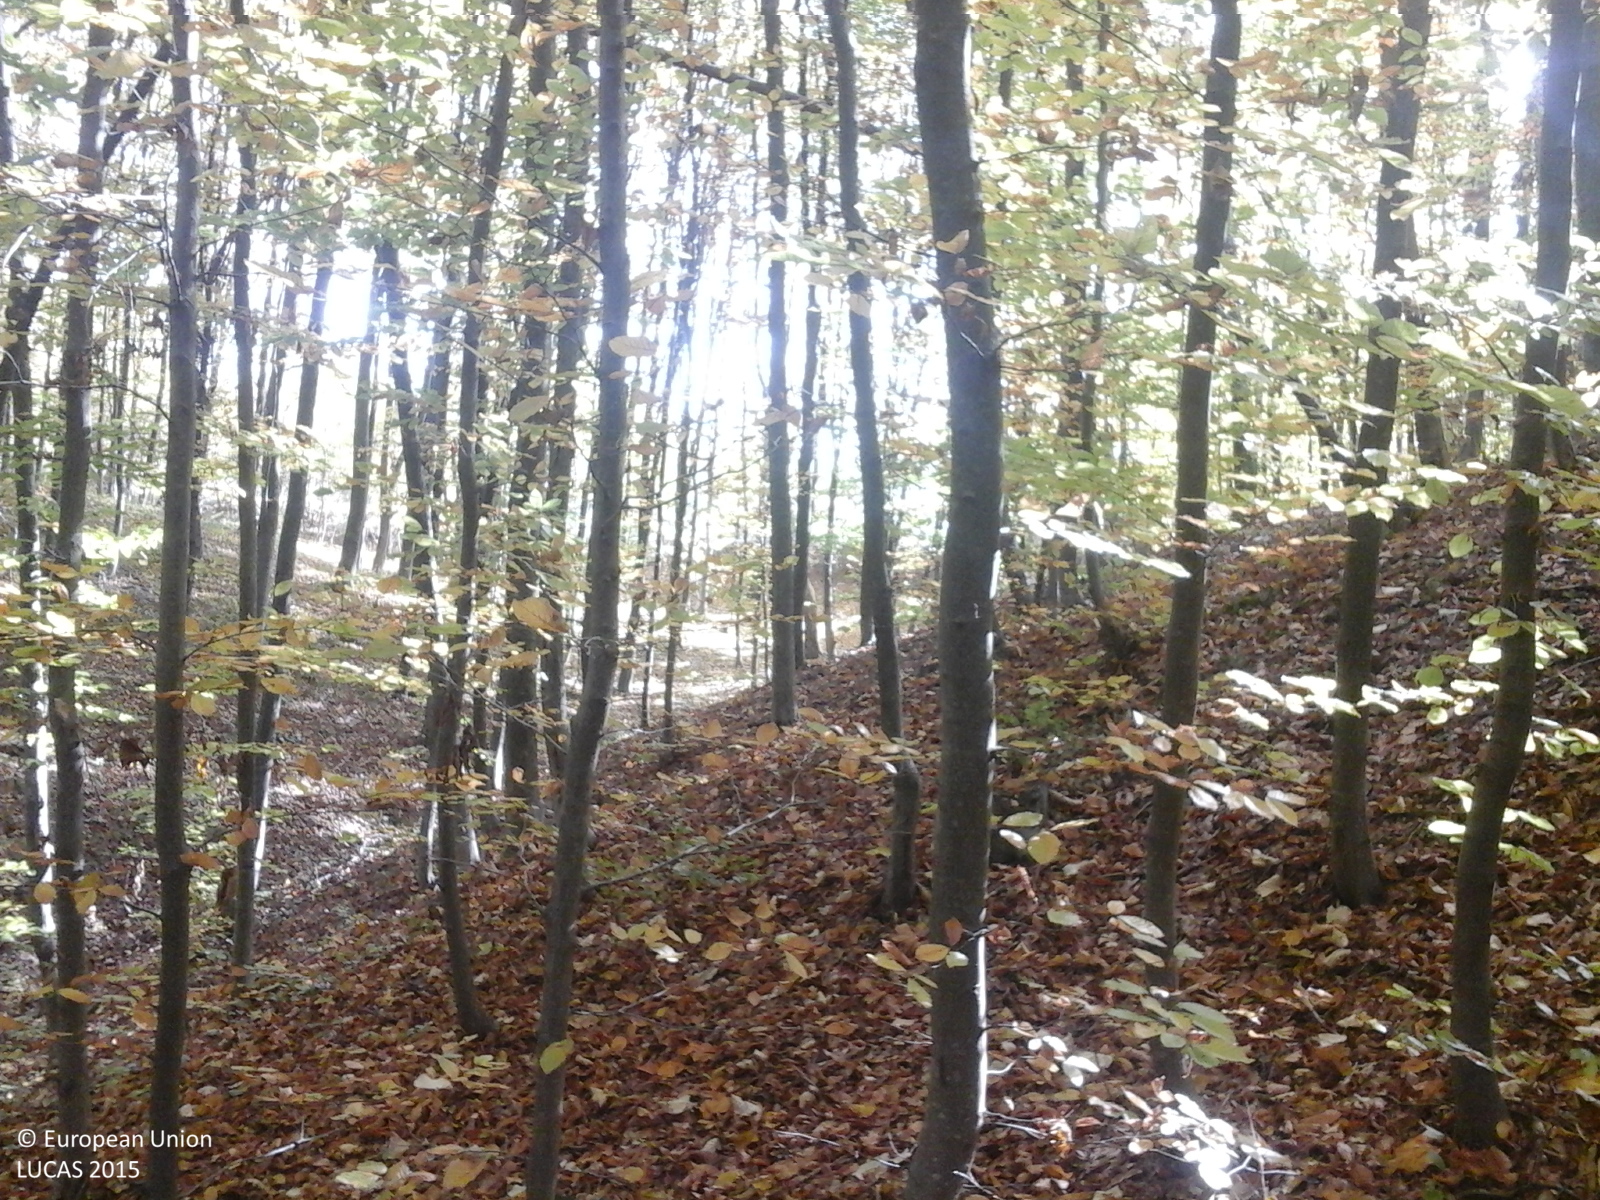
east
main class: Woodland
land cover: Broadleaved woodland
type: beech forest
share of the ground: > 75 %
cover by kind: broadleaved forest trees 100 %
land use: Forestry
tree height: > 5 m
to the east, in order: Broadleaved woodland; Rivers and streams; Broadleaved woodland; Tracks; Broadleaved woodland; Rivers and streams; Broadleaved woodland; Rivers and streams; Broadleaved woodland
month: October
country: RO
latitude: 45.1420
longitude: 26.4368
